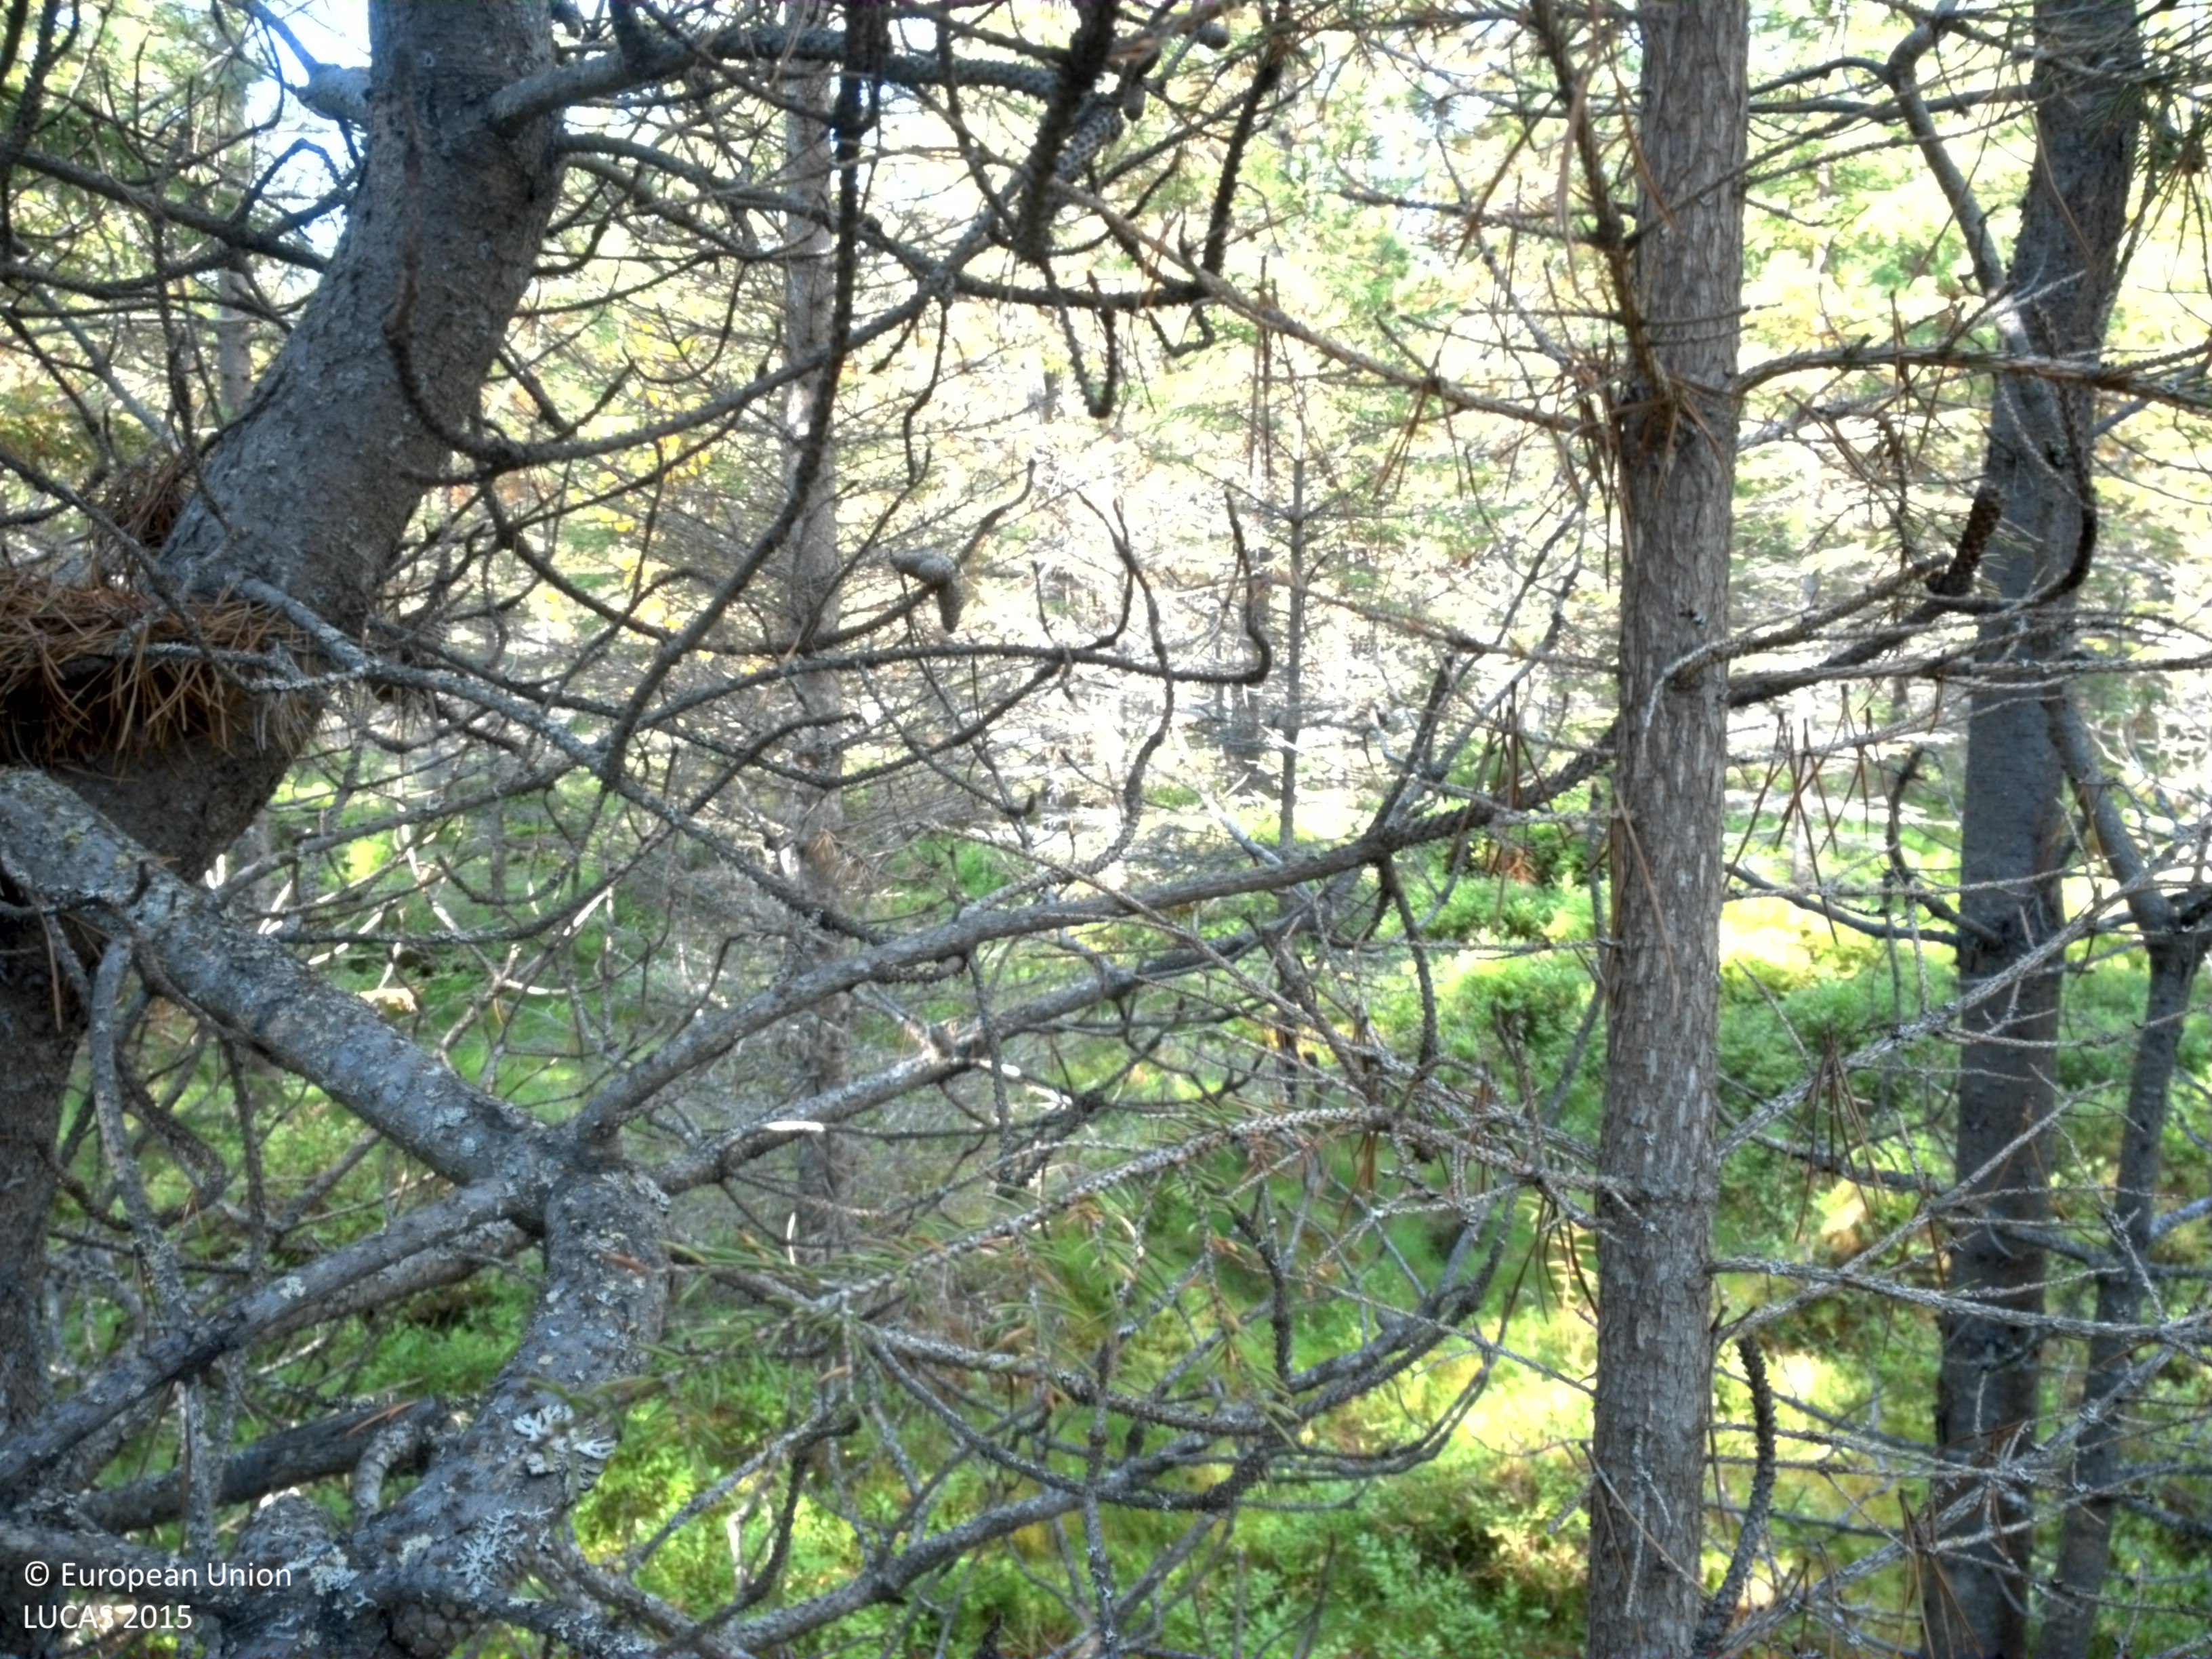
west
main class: Woodland
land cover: Pine dominated coniferous woodland
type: exotic forest
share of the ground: 50 - 75 %
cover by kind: coniferous forest trees 55 %, shrubs 30 %, broadleaved forest trees 5 %, herbaceous plants 5 %, lichens and mosses 5 %
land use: Forestry
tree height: > 5 m
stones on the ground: < 10 %
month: September
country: SE
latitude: 65.1212
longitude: 16.8442
